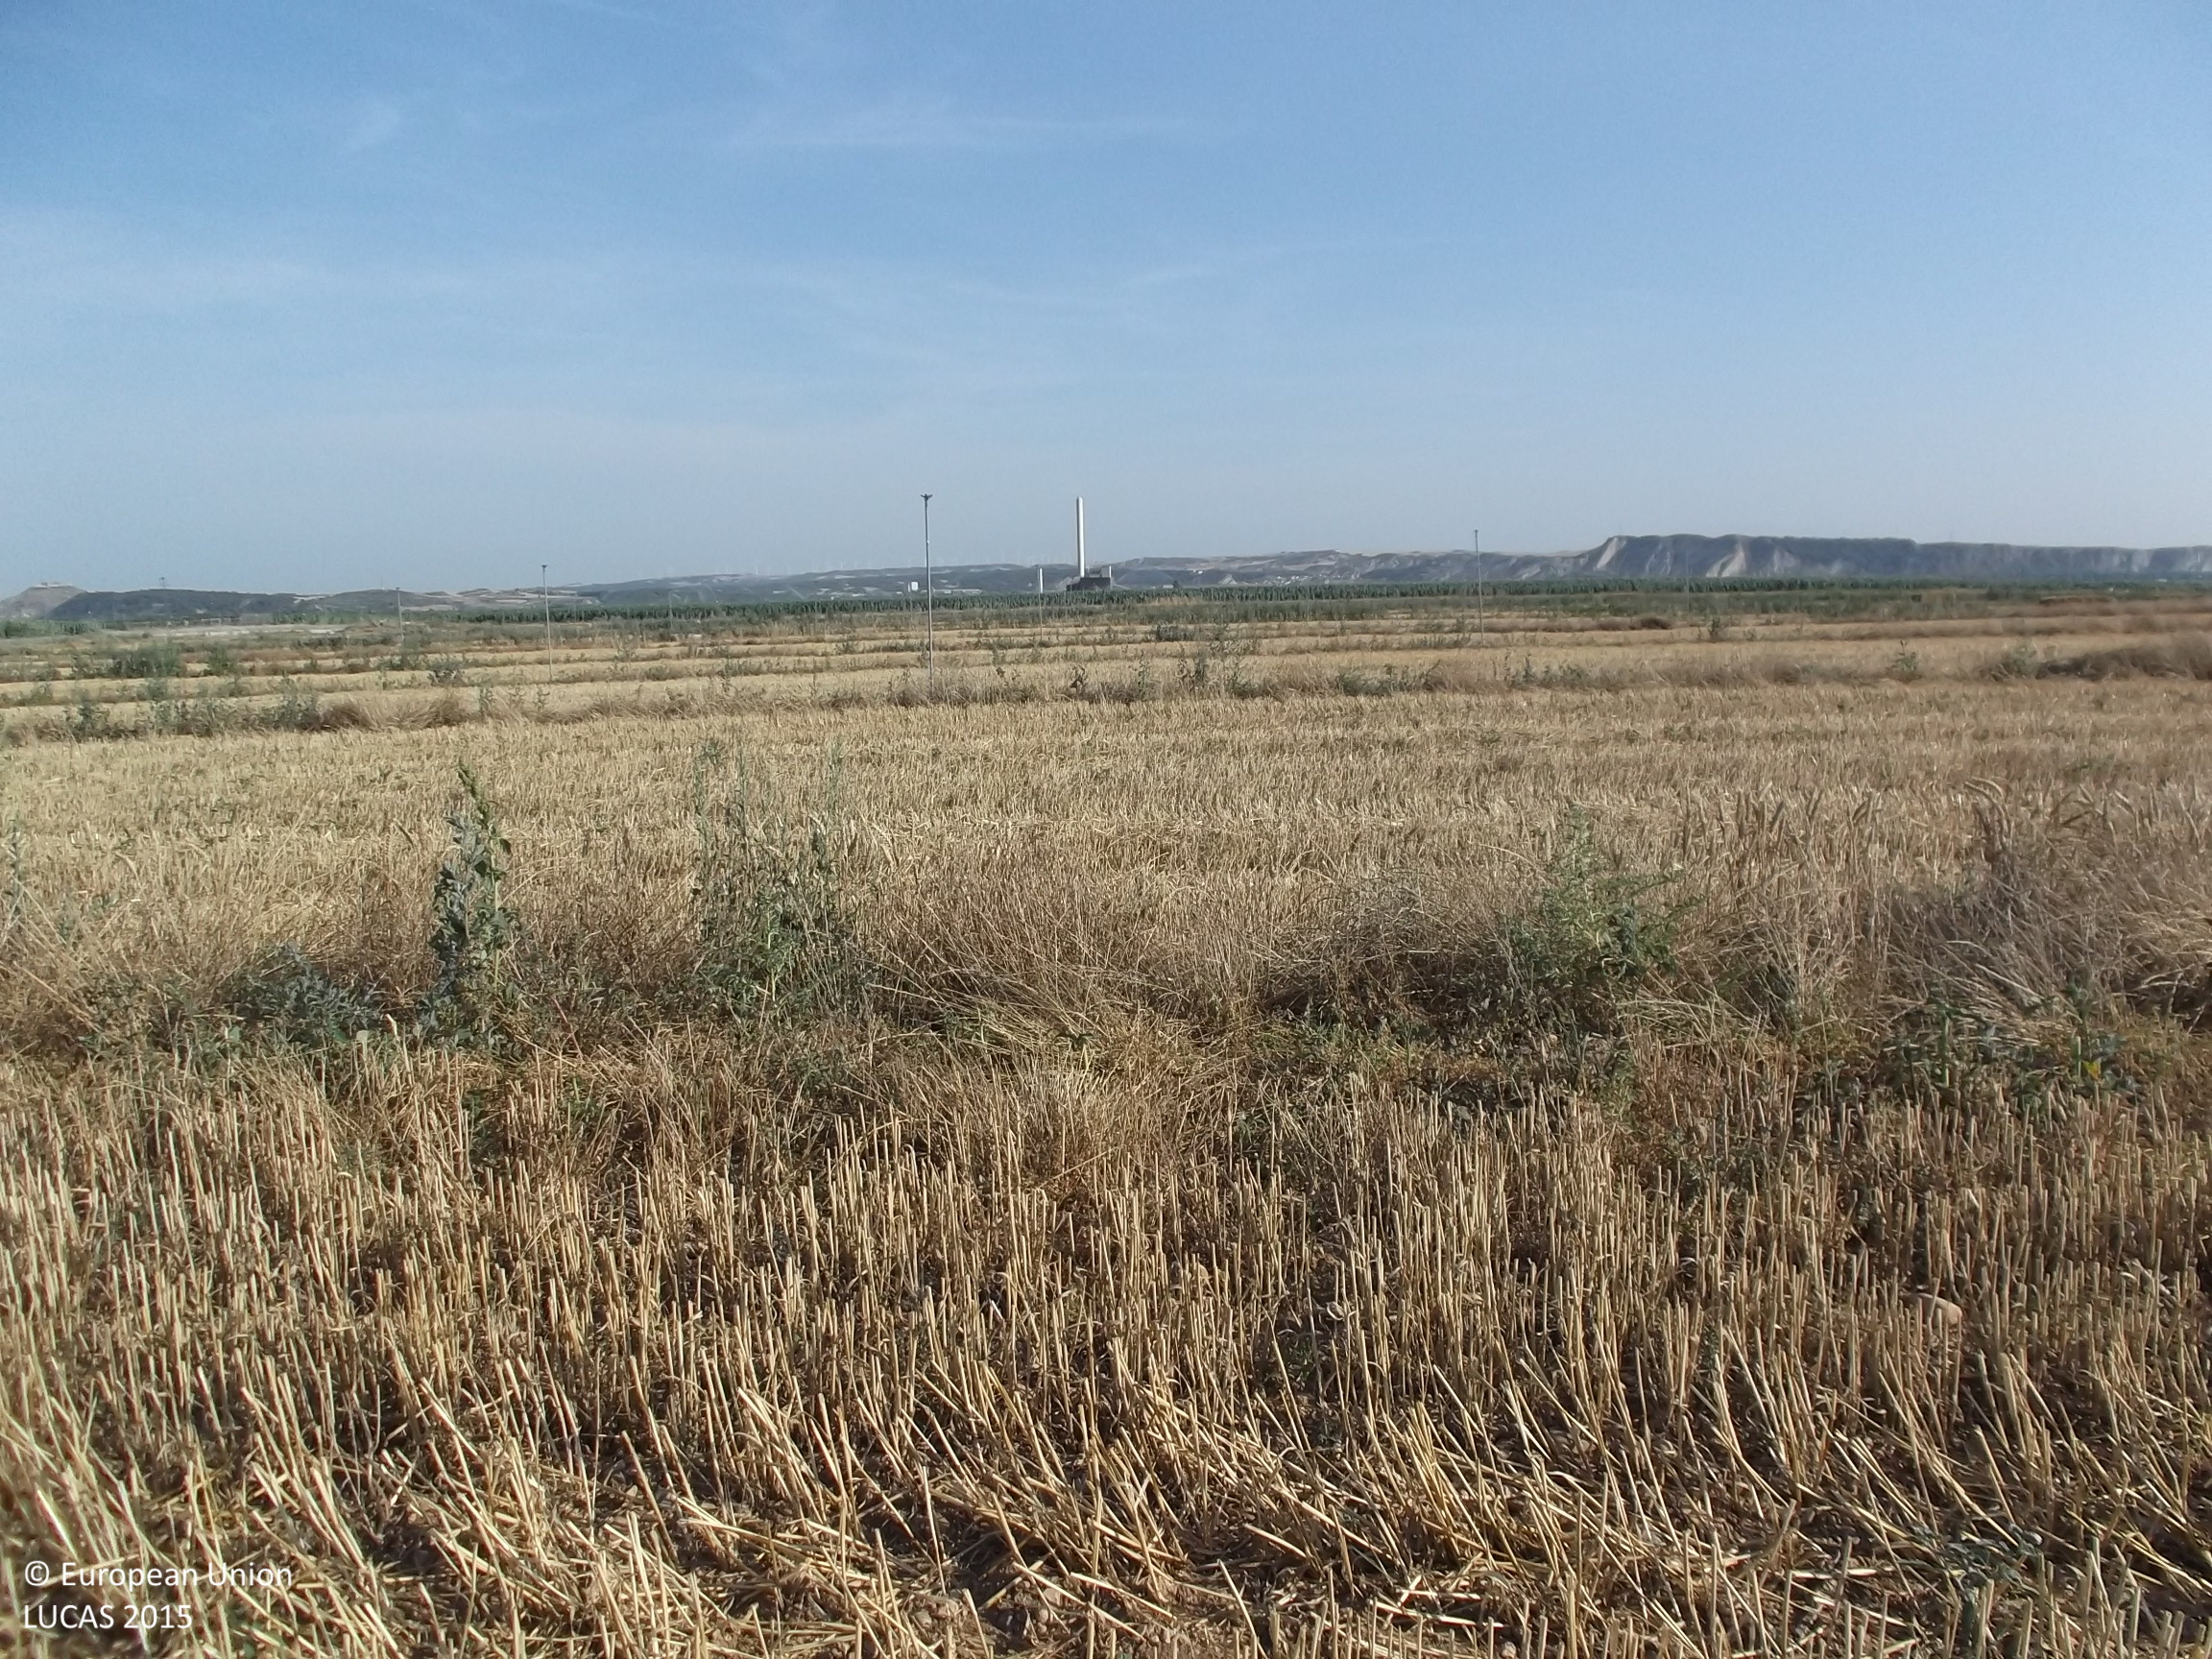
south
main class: Cropland
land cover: Common wheat
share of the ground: < 10 %
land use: Agriculture (excluding fallow land and kitchen gardens)
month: July
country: ES
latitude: 42.3794
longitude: -1.6583
